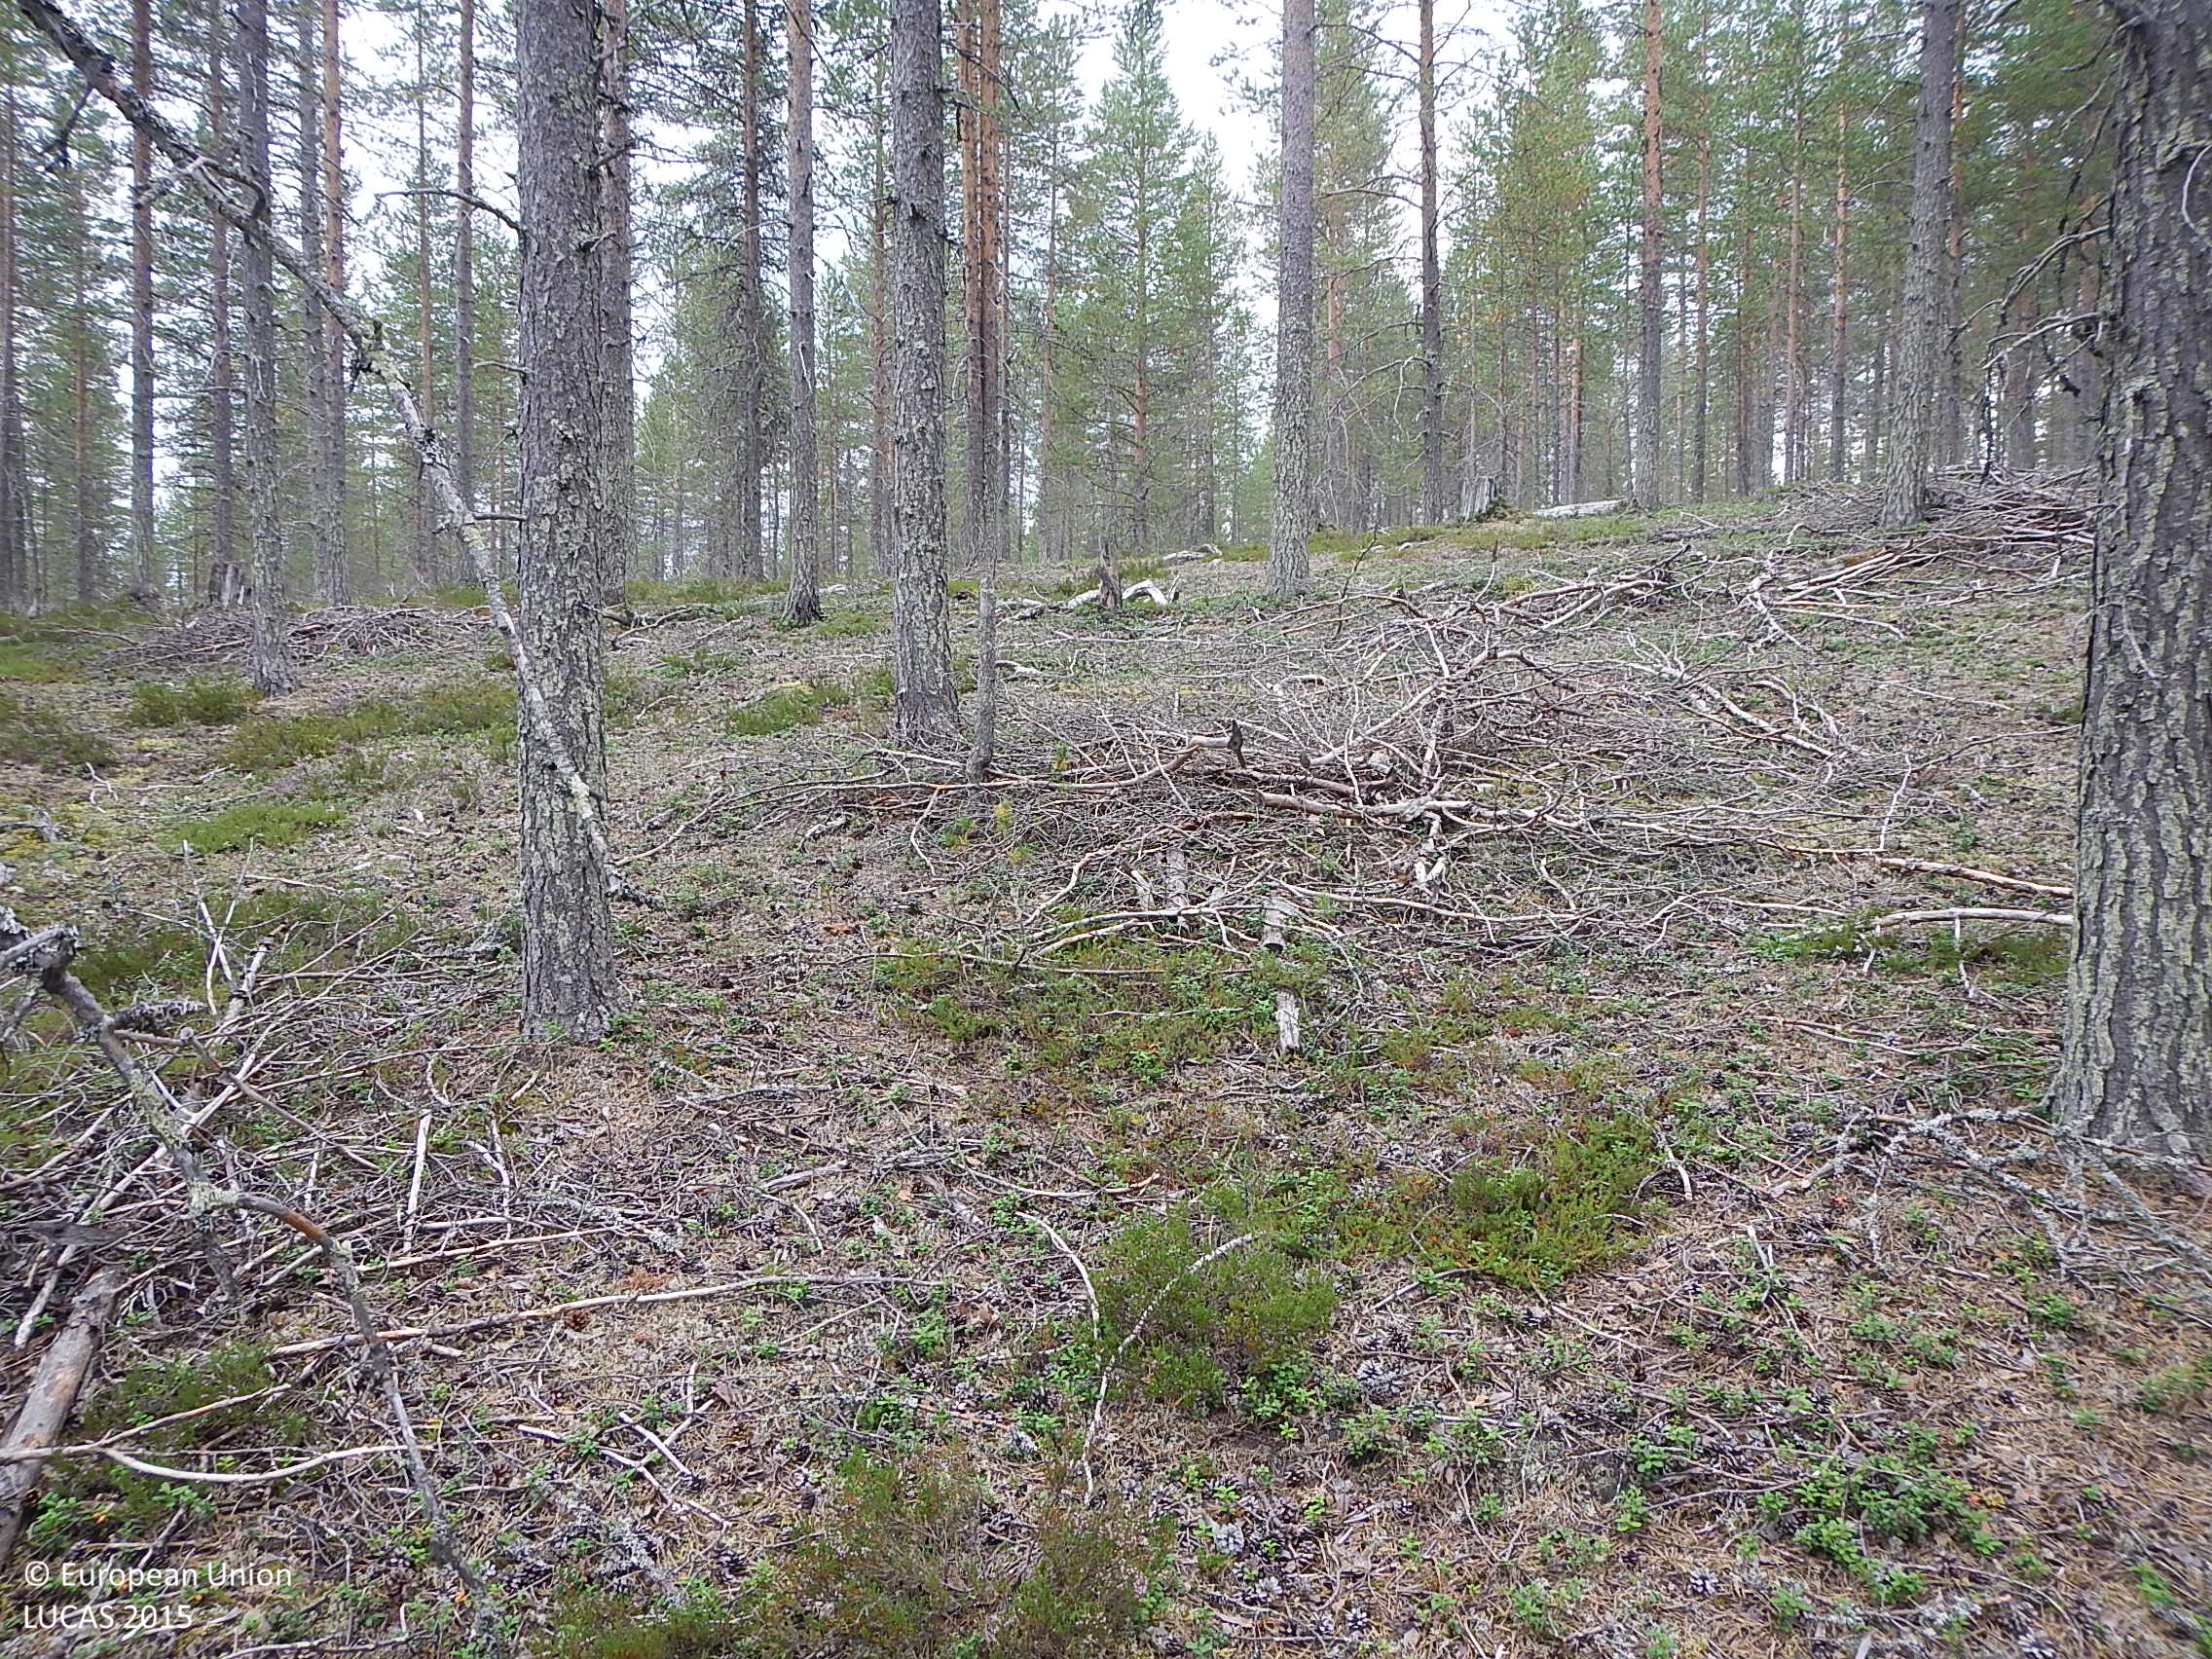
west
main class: Woodland
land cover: Pine dominated coniferous woodland
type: boreal forest
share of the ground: 50 - 75 %
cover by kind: coniferous forest trees 60 %, shrubs 30 %, lichens and mosses 10 %
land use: Forestry
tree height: > 5 m
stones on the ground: < 10 %
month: August
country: FI
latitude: 66.0489
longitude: 27.7676
